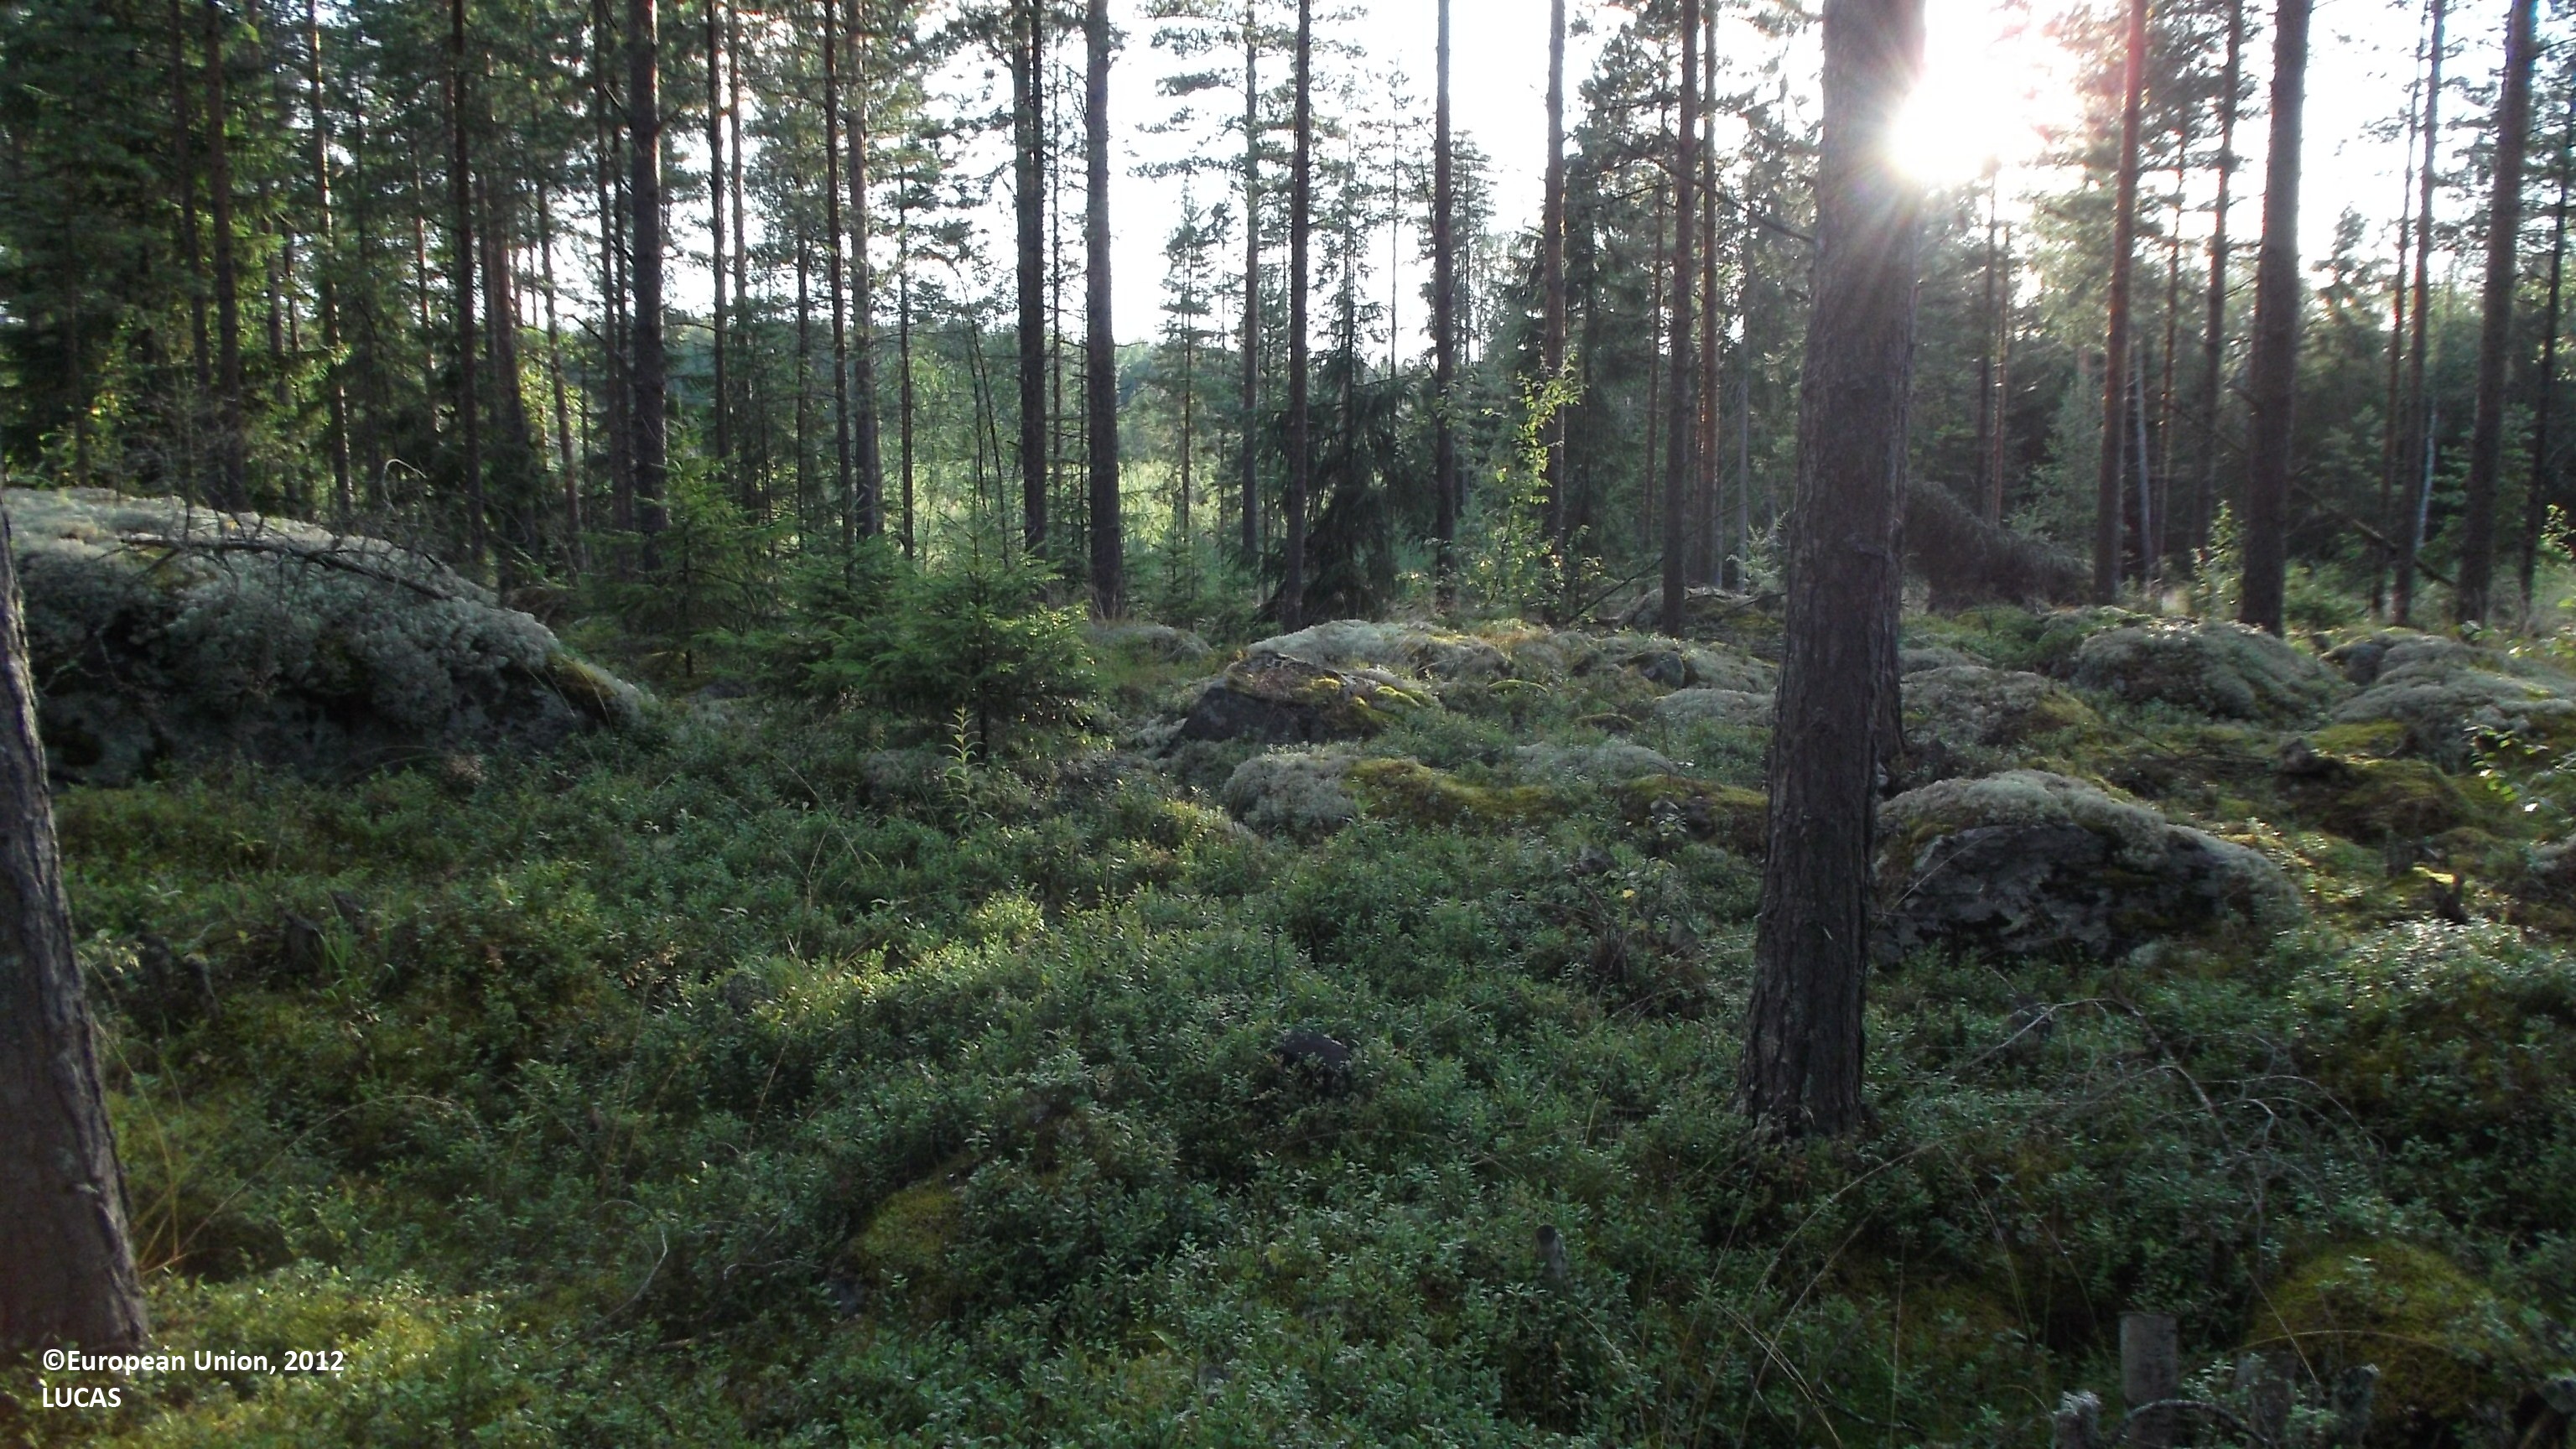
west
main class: Woodland
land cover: Pine dominated coniferous woodland
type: boreal forest
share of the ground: 25 - 50 %
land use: Forestry
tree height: > 5 m
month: August
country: FI
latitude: 63.8717
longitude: 23.3048
